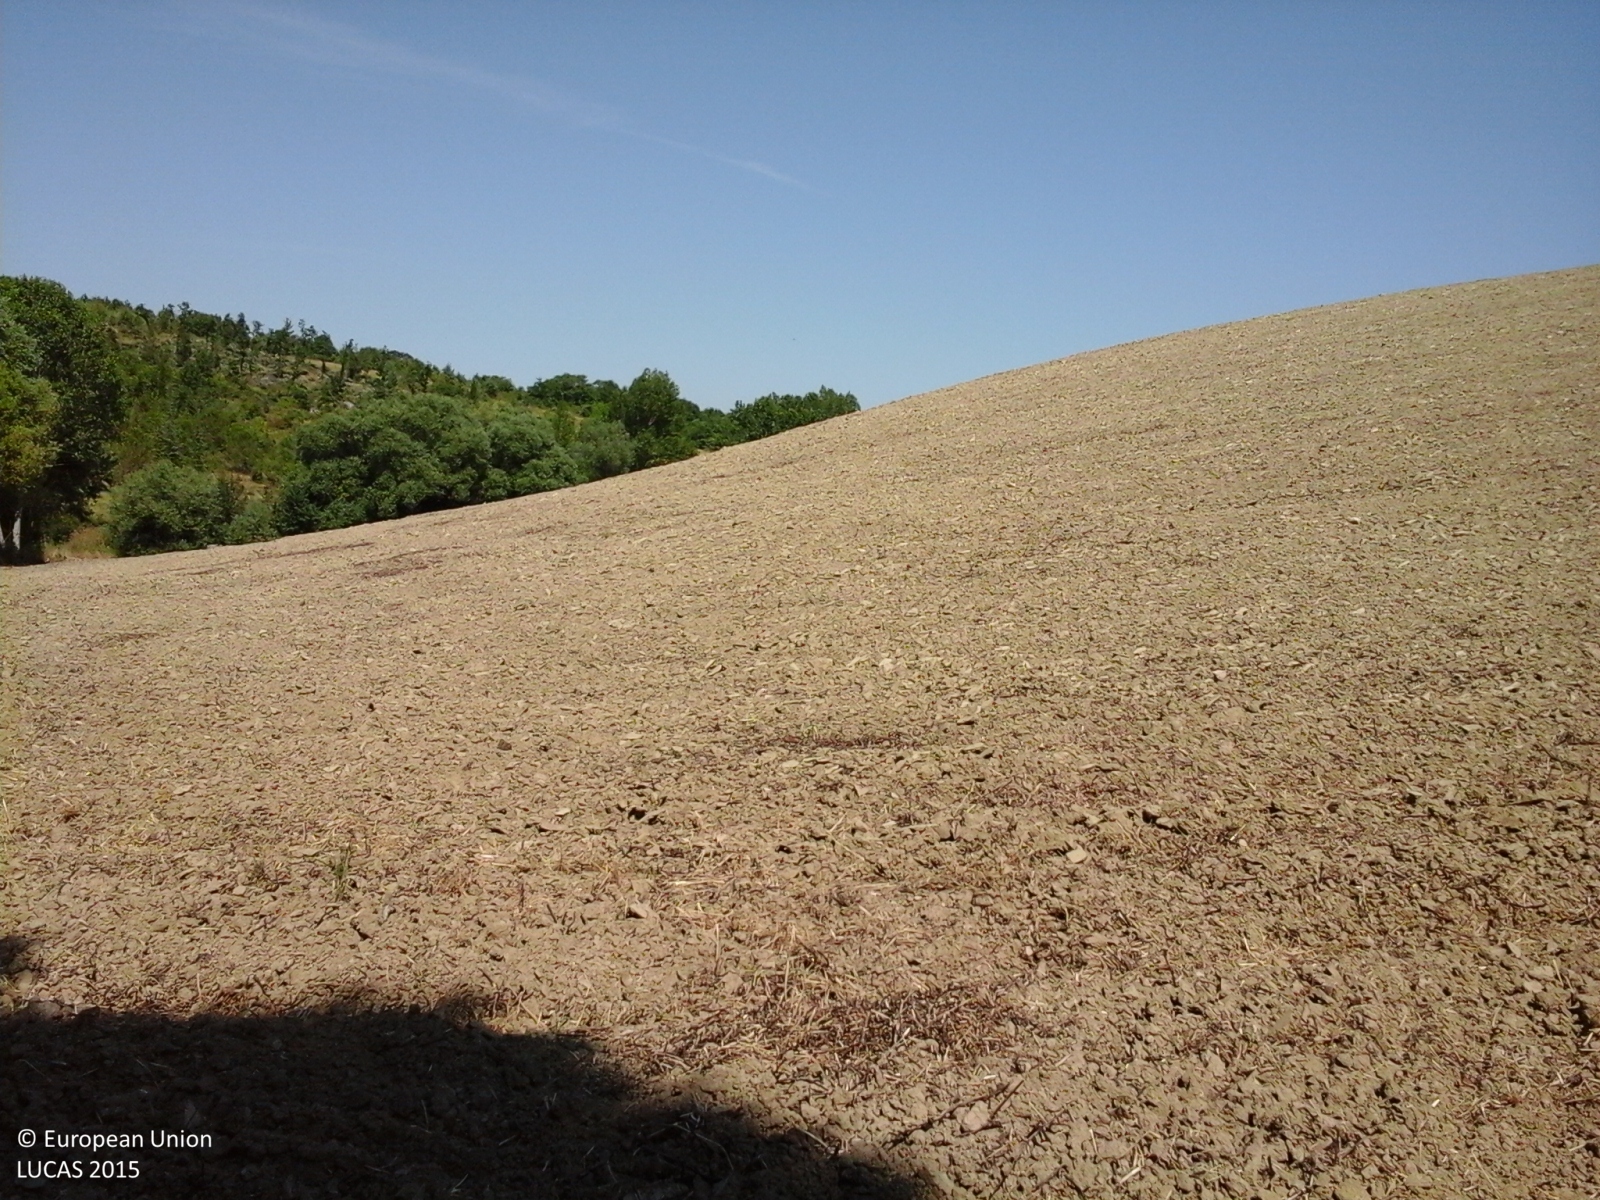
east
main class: Woodland
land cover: Broadleaved woodland
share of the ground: > 75 %
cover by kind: broadleaved forest trees 85 %, shrubs 10 %, herbaceous plants 5 %
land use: Semi-natural and natural areas not in use
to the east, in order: Broadleaved woodland; Dry pulses; Durum wheat; Broadleaved woodland; Grassland without tree/shrub cover
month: July
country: IT
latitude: 41.5848
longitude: 14.7218
